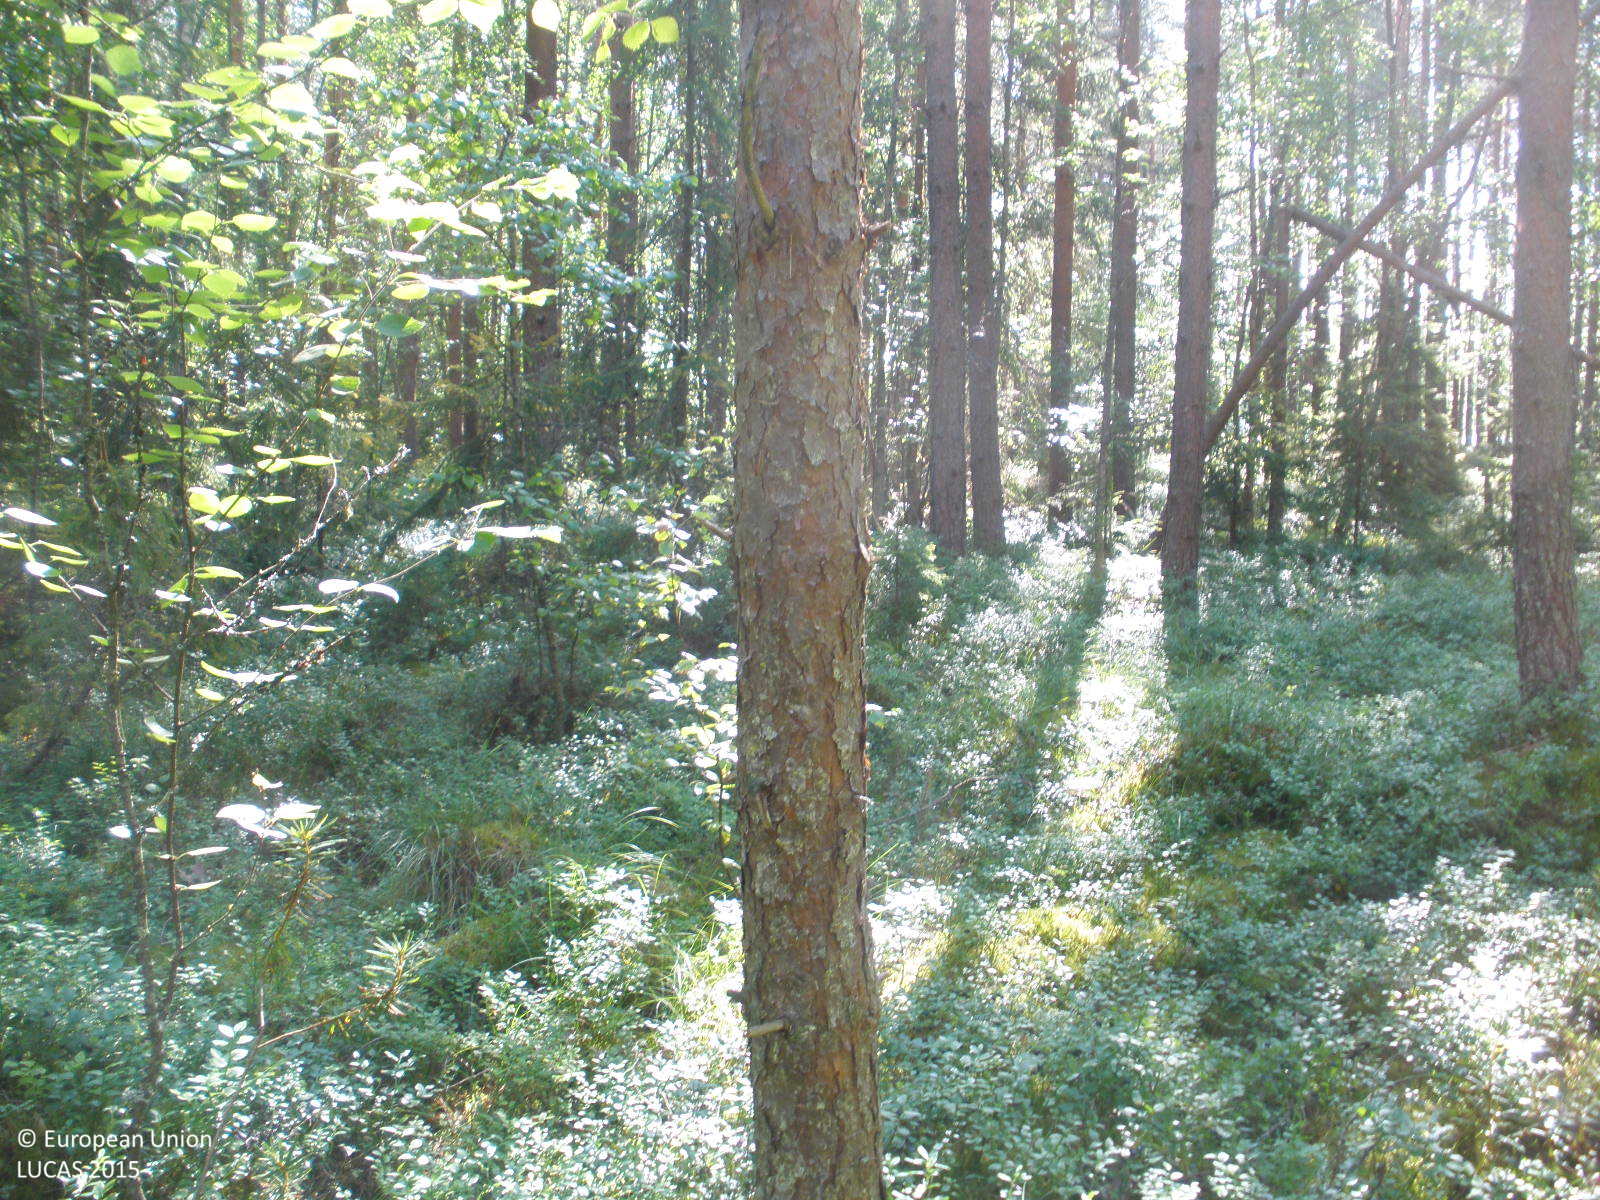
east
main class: Woodland
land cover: Pine dominated mixed woodland
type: boreal forest
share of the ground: > 75 %
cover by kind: coniferous forest trees 60 %, broadleaved forest trees 25 %, shrubs 5 %, herbaceous plants 5 %, lichens and mosses 5 %
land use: Forestry
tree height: > 5 m
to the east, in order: Pine dominated mixed woodland; Ditches and canals; Pine dominated mixed woodland; Artificial constructions in urban areas; Ditches and canals; Pine dominated mixed woodland; Inland marshes; Pine dominated mixed woodland; Artificial constructions in urban areas
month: August
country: FI
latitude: 60.9489
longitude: 24.8613
